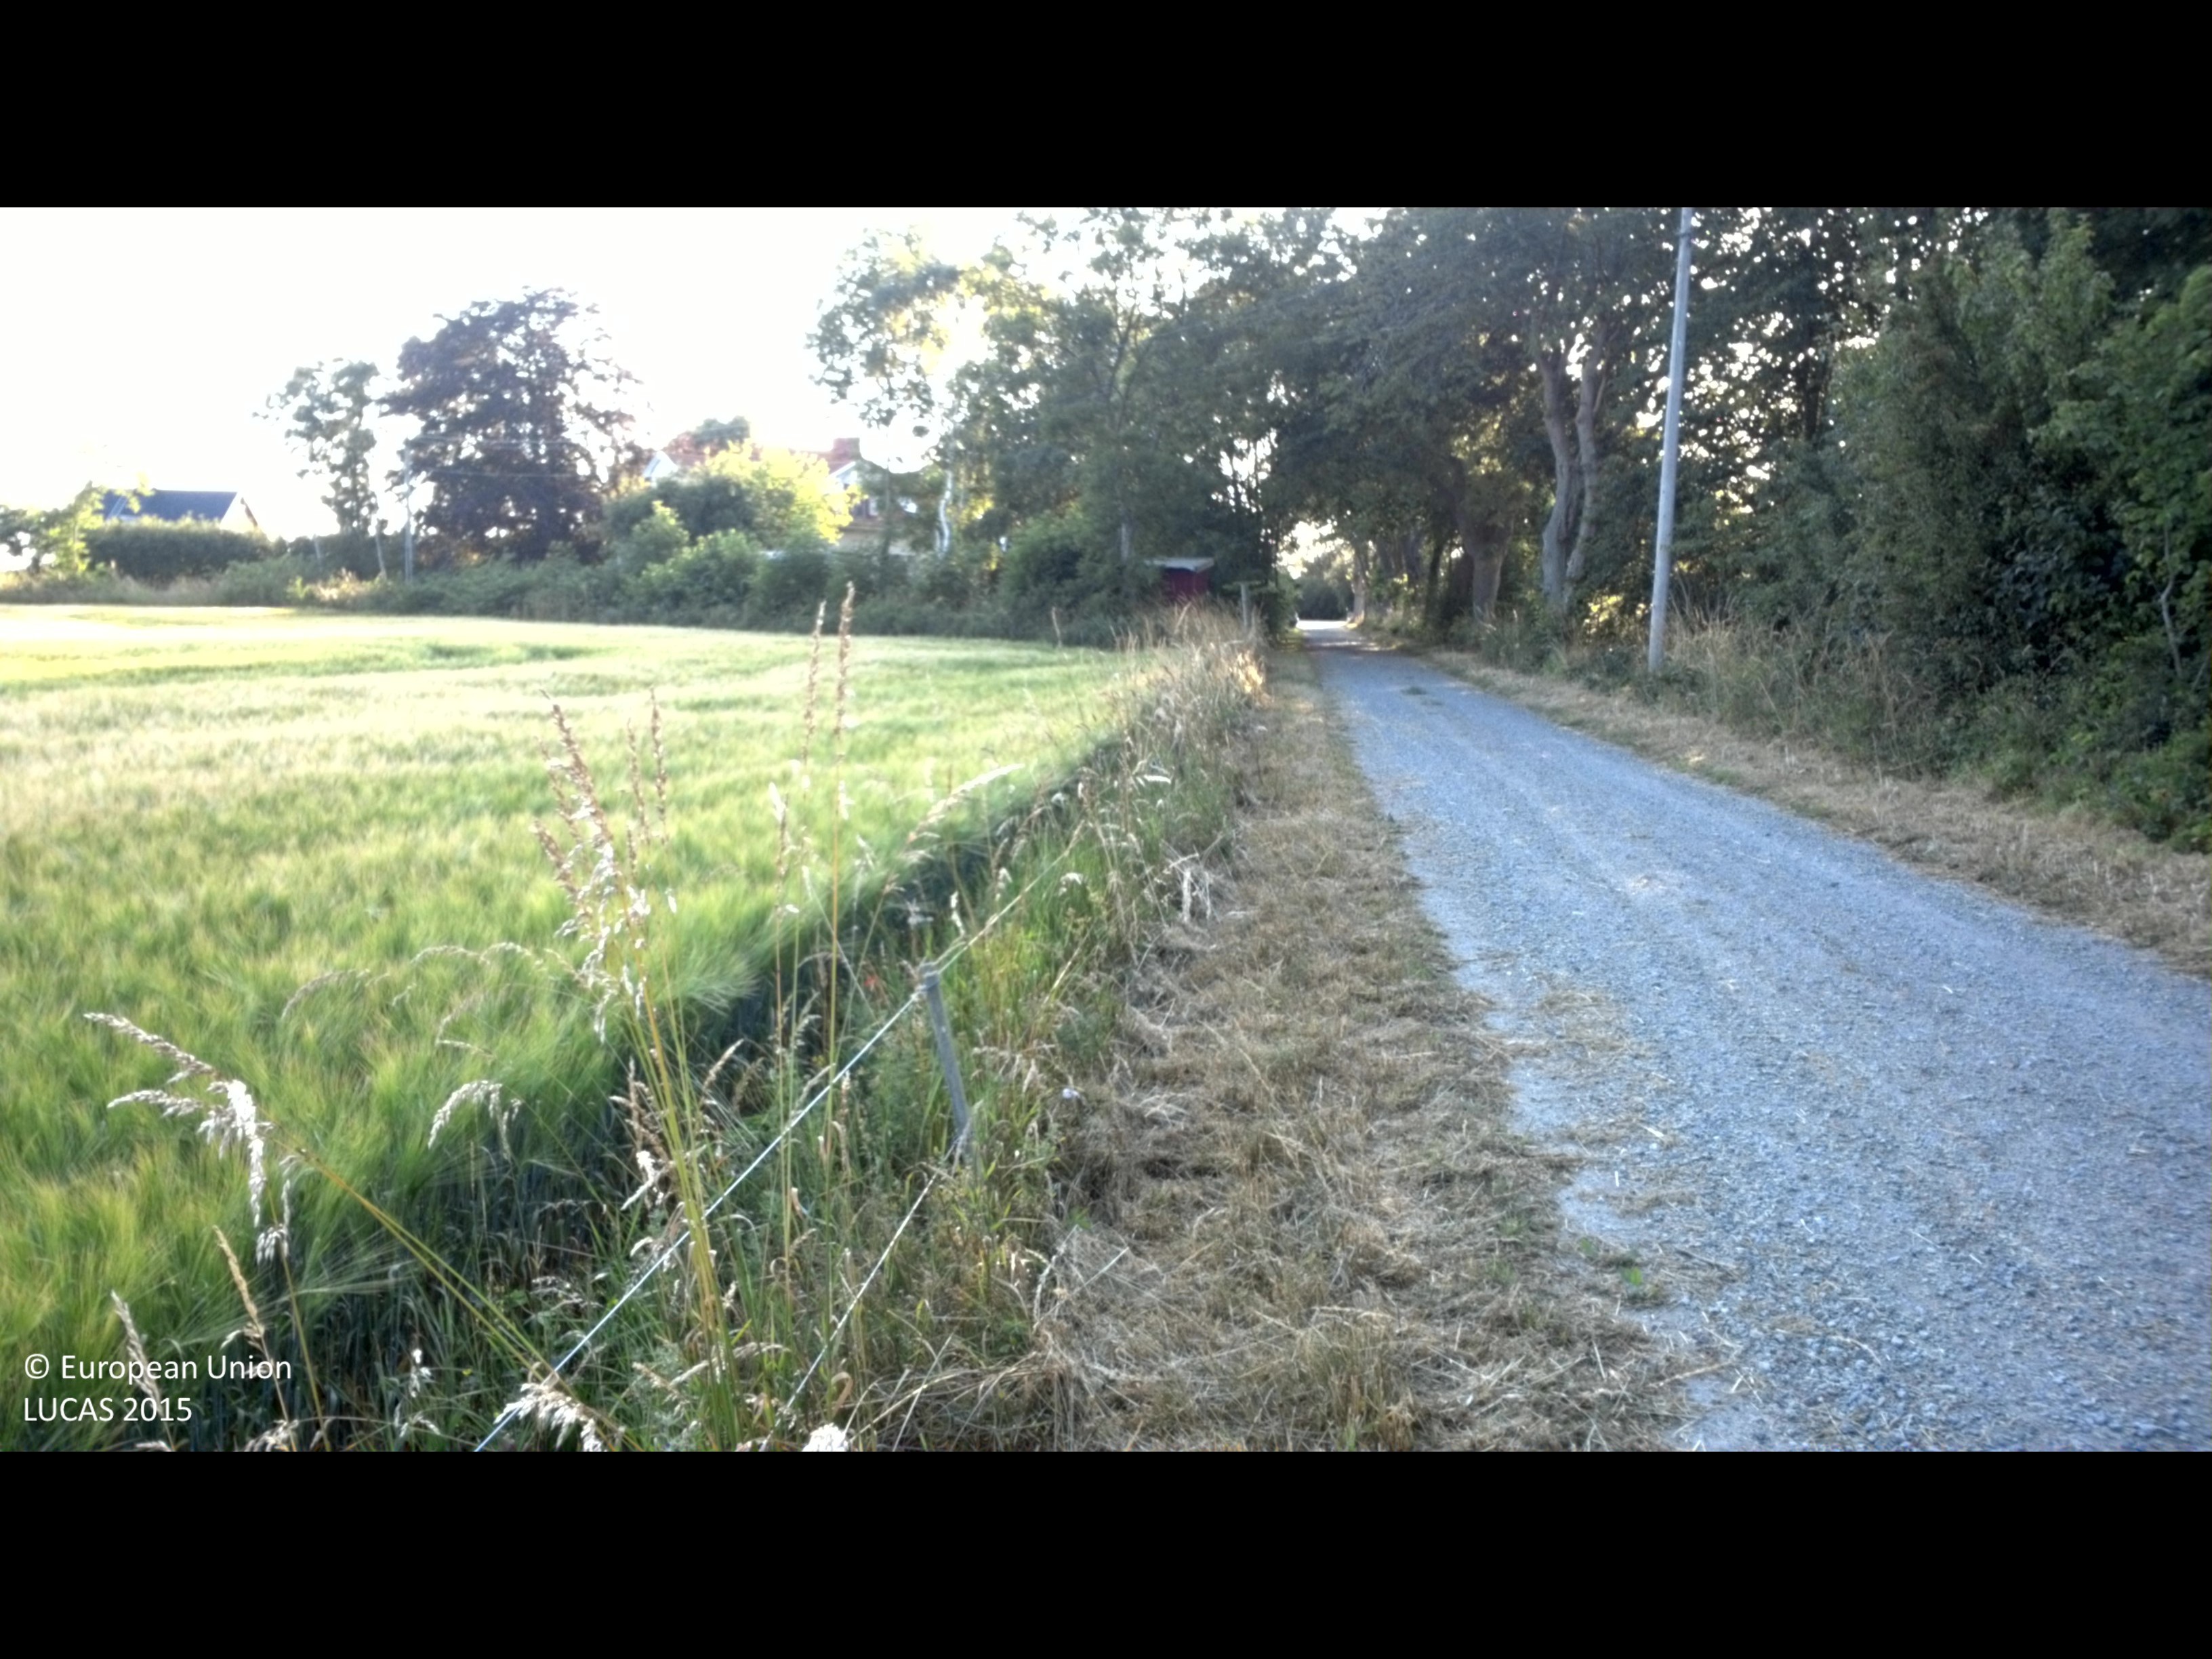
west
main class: Cropland
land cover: Barley
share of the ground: > 75 %
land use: Agriculture (excluding fallow land and kitchen gardens)
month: July
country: SE
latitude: 56.2620
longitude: 16.4113
